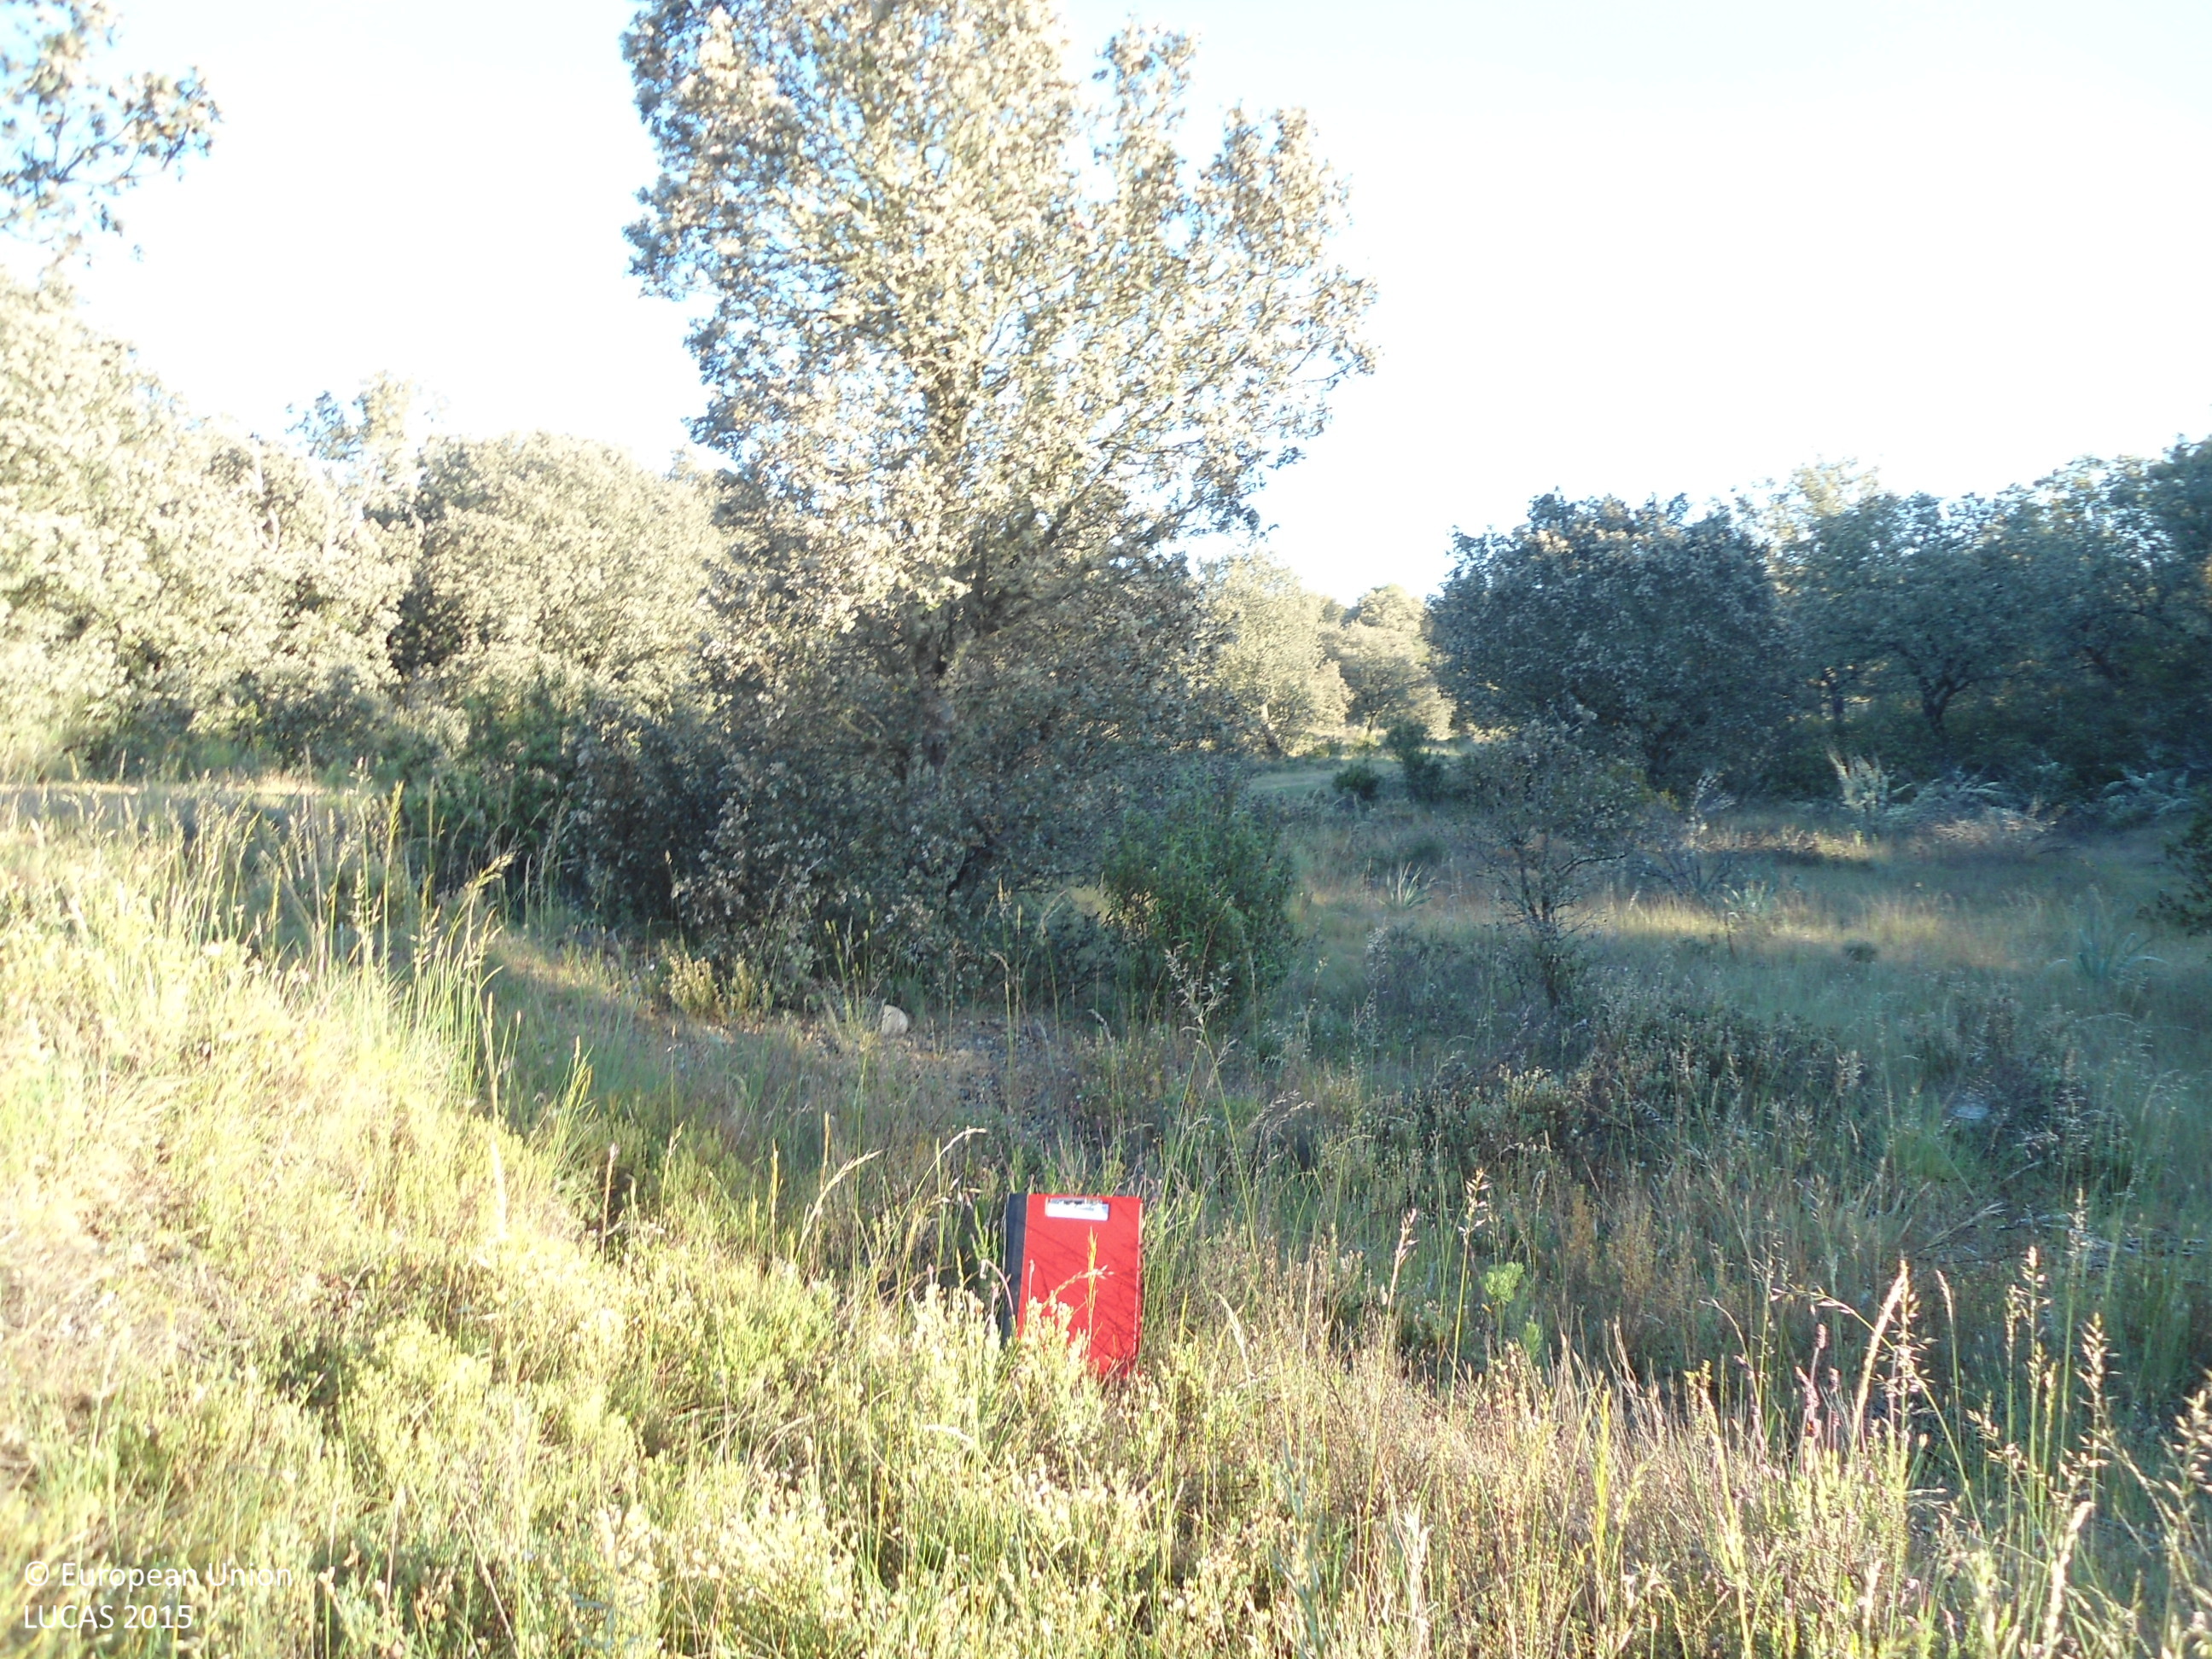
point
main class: Woodland
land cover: Broadleaved woodland
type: broadleaved evergreen forest
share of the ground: 50 - 75 %
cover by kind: broadleaved forest trees 60 %, shrubs 20 %, herbaceous plants 20 %
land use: Forestry
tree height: > 5 m
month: May
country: ES
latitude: 41.9700
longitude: -5.9410
